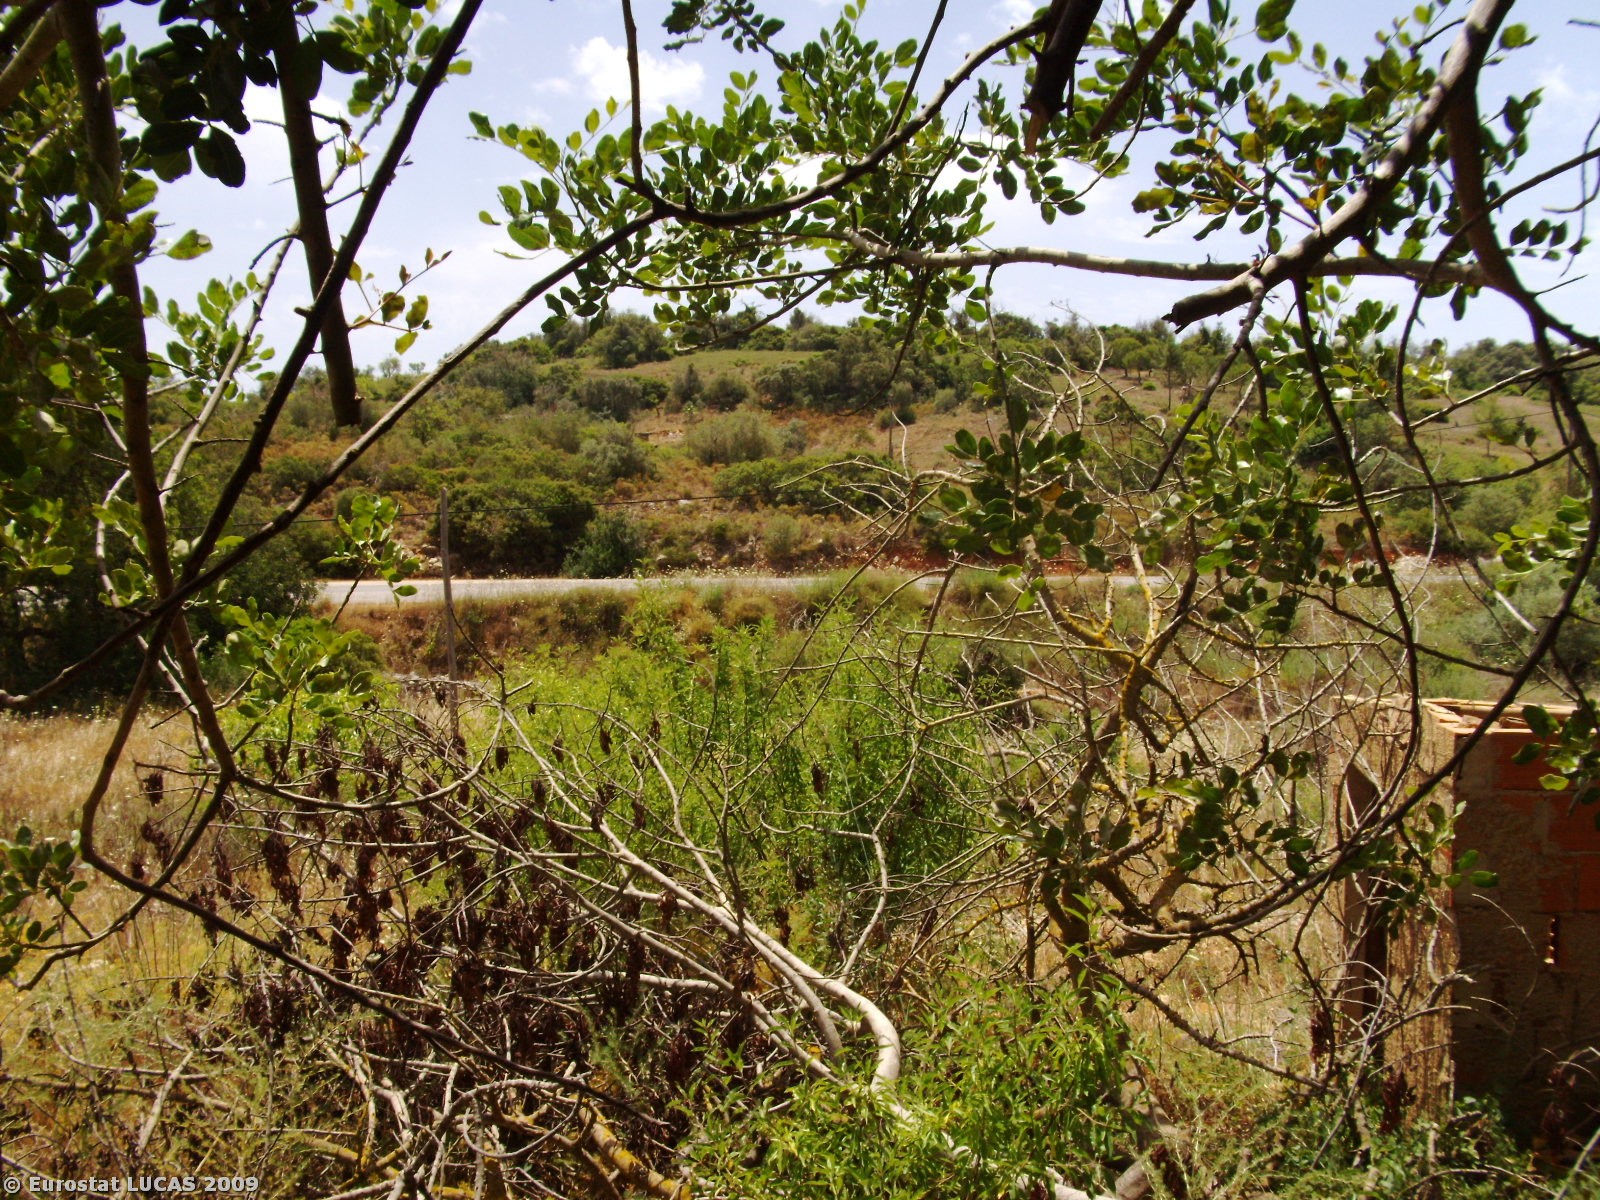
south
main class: Cropland
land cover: Permanent industrial crops
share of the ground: 25 - 50 %
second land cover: Spontaneously vegetated surfaces
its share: 50 - 75 %
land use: Fallow land
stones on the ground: < 10 %
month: May
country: PT
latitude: 37.1610
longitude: -8.4810
